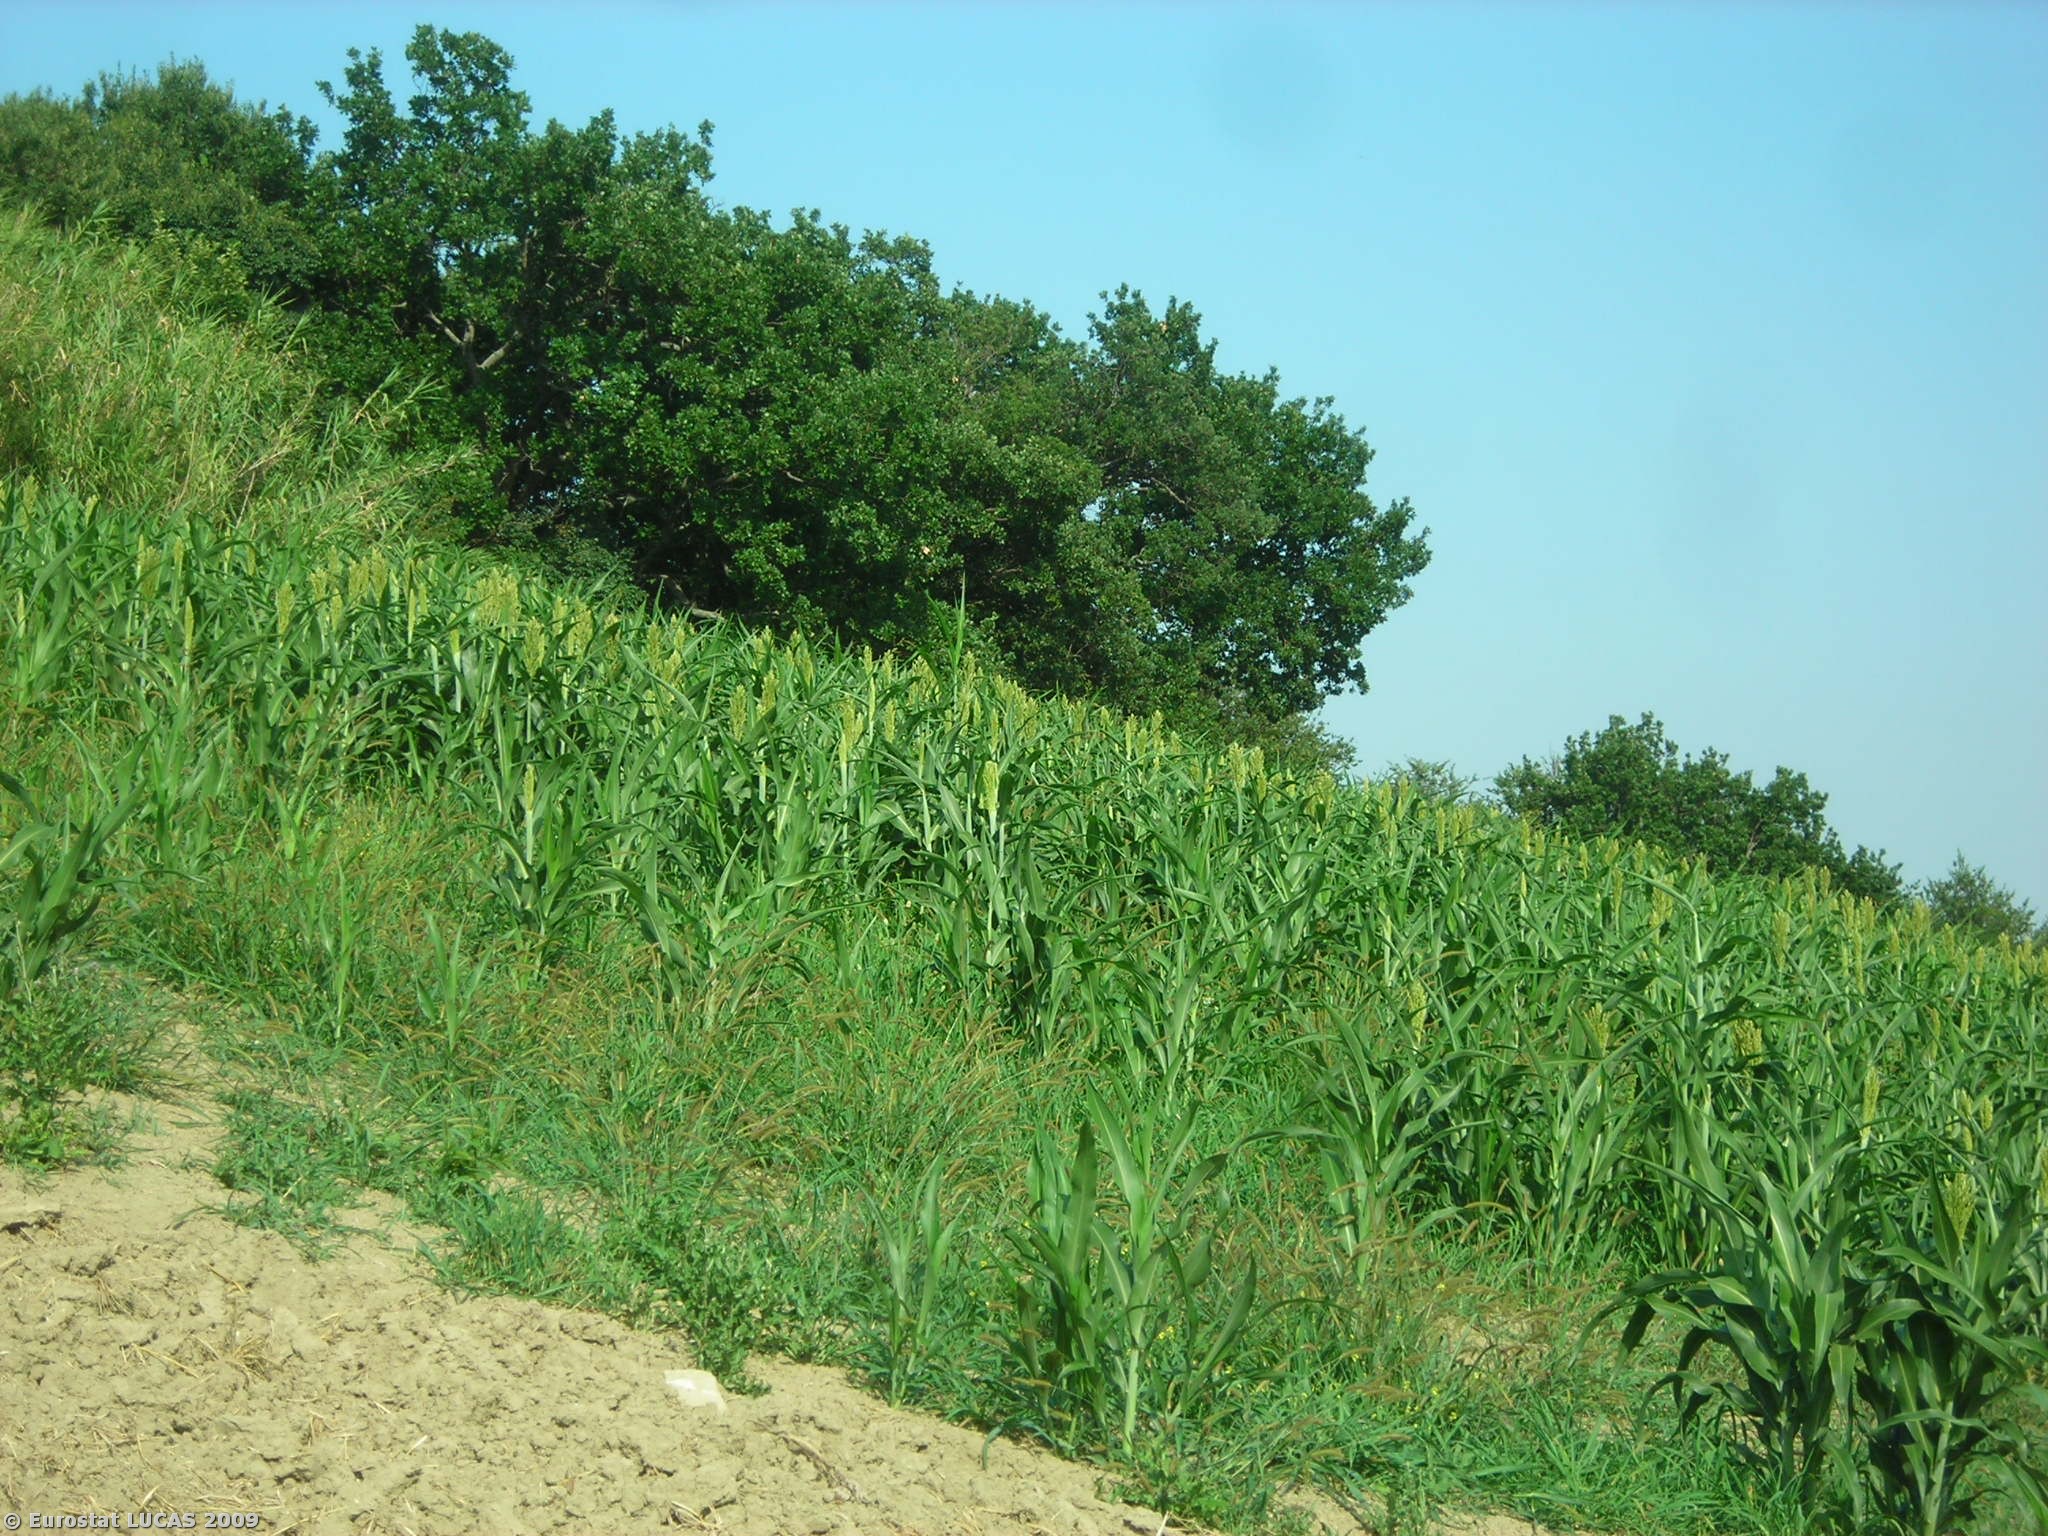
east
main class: Cropland
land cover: Barley
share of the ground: < 10 %
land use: Agriculture (excluding fallow land and kitchen gardens)
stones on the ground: < 10 %
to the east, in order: Barley; Other cereals; Grass margins; Shrubland without tree cover; Sunflower; Abandoned hedges; Fences; Grassland with sparse tree/shrub cover
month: July
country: IT
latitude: 43.3972
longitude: 13.2389
